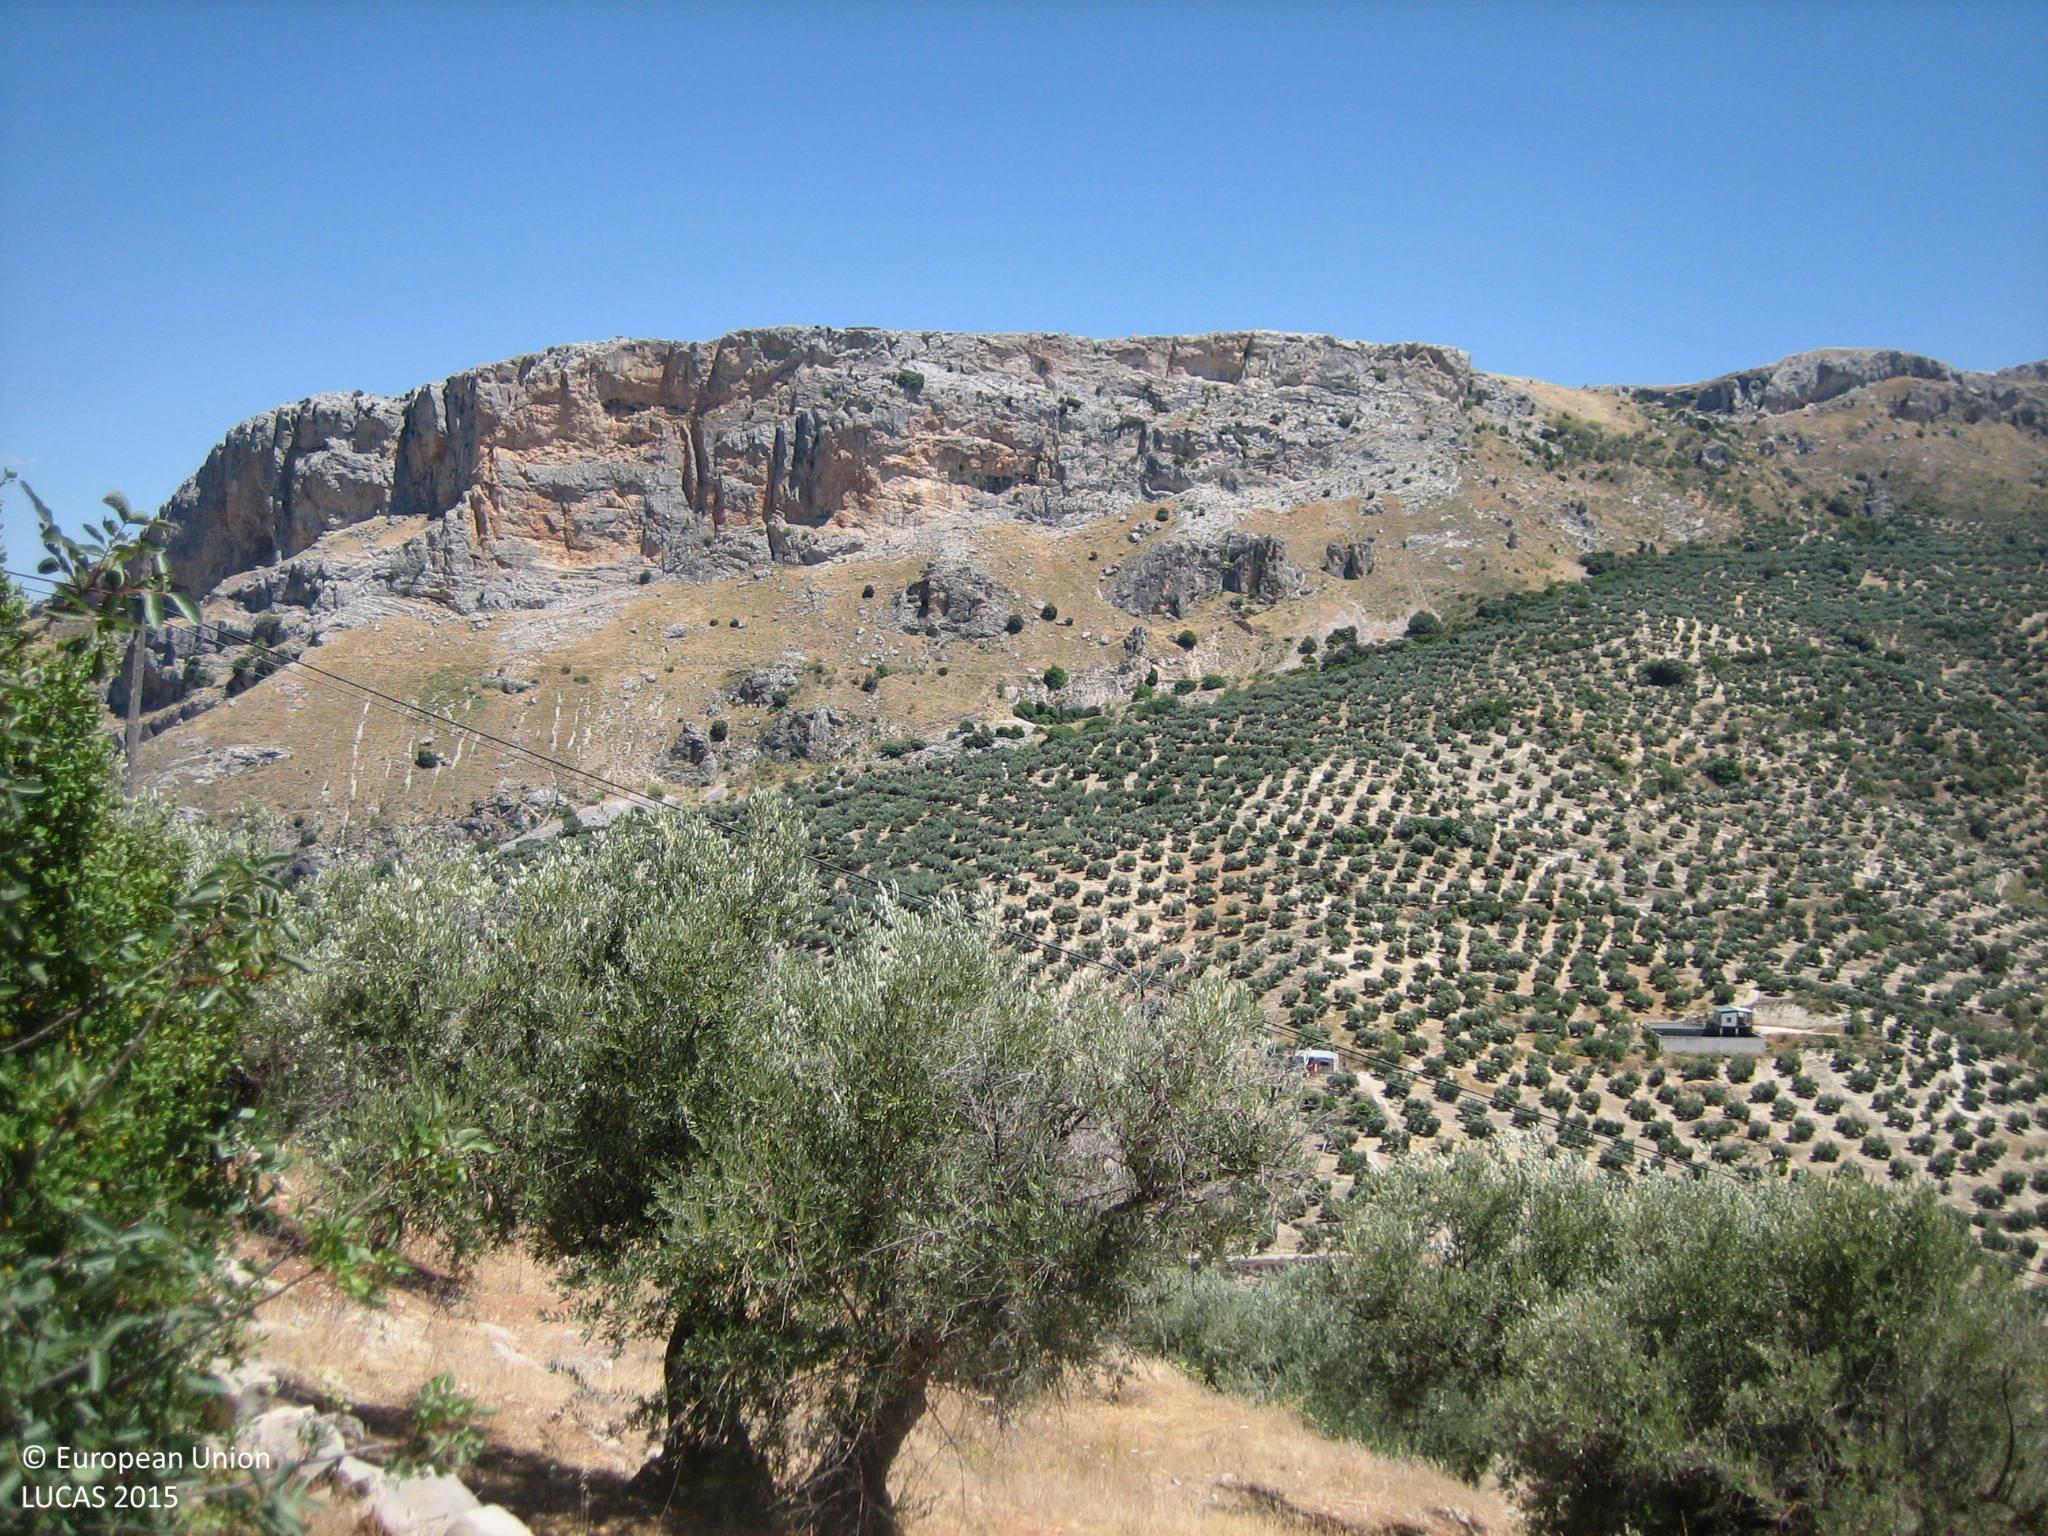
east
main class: Cropland
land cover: Olive groves
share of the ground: 10 - 25 %
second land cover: Spontaneously vegetated surfaces
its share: 10 - 25 %
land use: Agriculture (excluding fallow land and kitchen gardens)
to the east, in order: Olive groves; Spontaneously vegetated surfaces; Single bushes/trees; Olive groves; Electric lines; Olive groves; Paved roads, cycling and walking lanes; Shrubland with sparse tree cover; Tracks; Olive groves; Tracks; Olive groves; Shrubland without tree cover
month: June
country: ES
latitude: 37.7088
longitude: -3.8045
